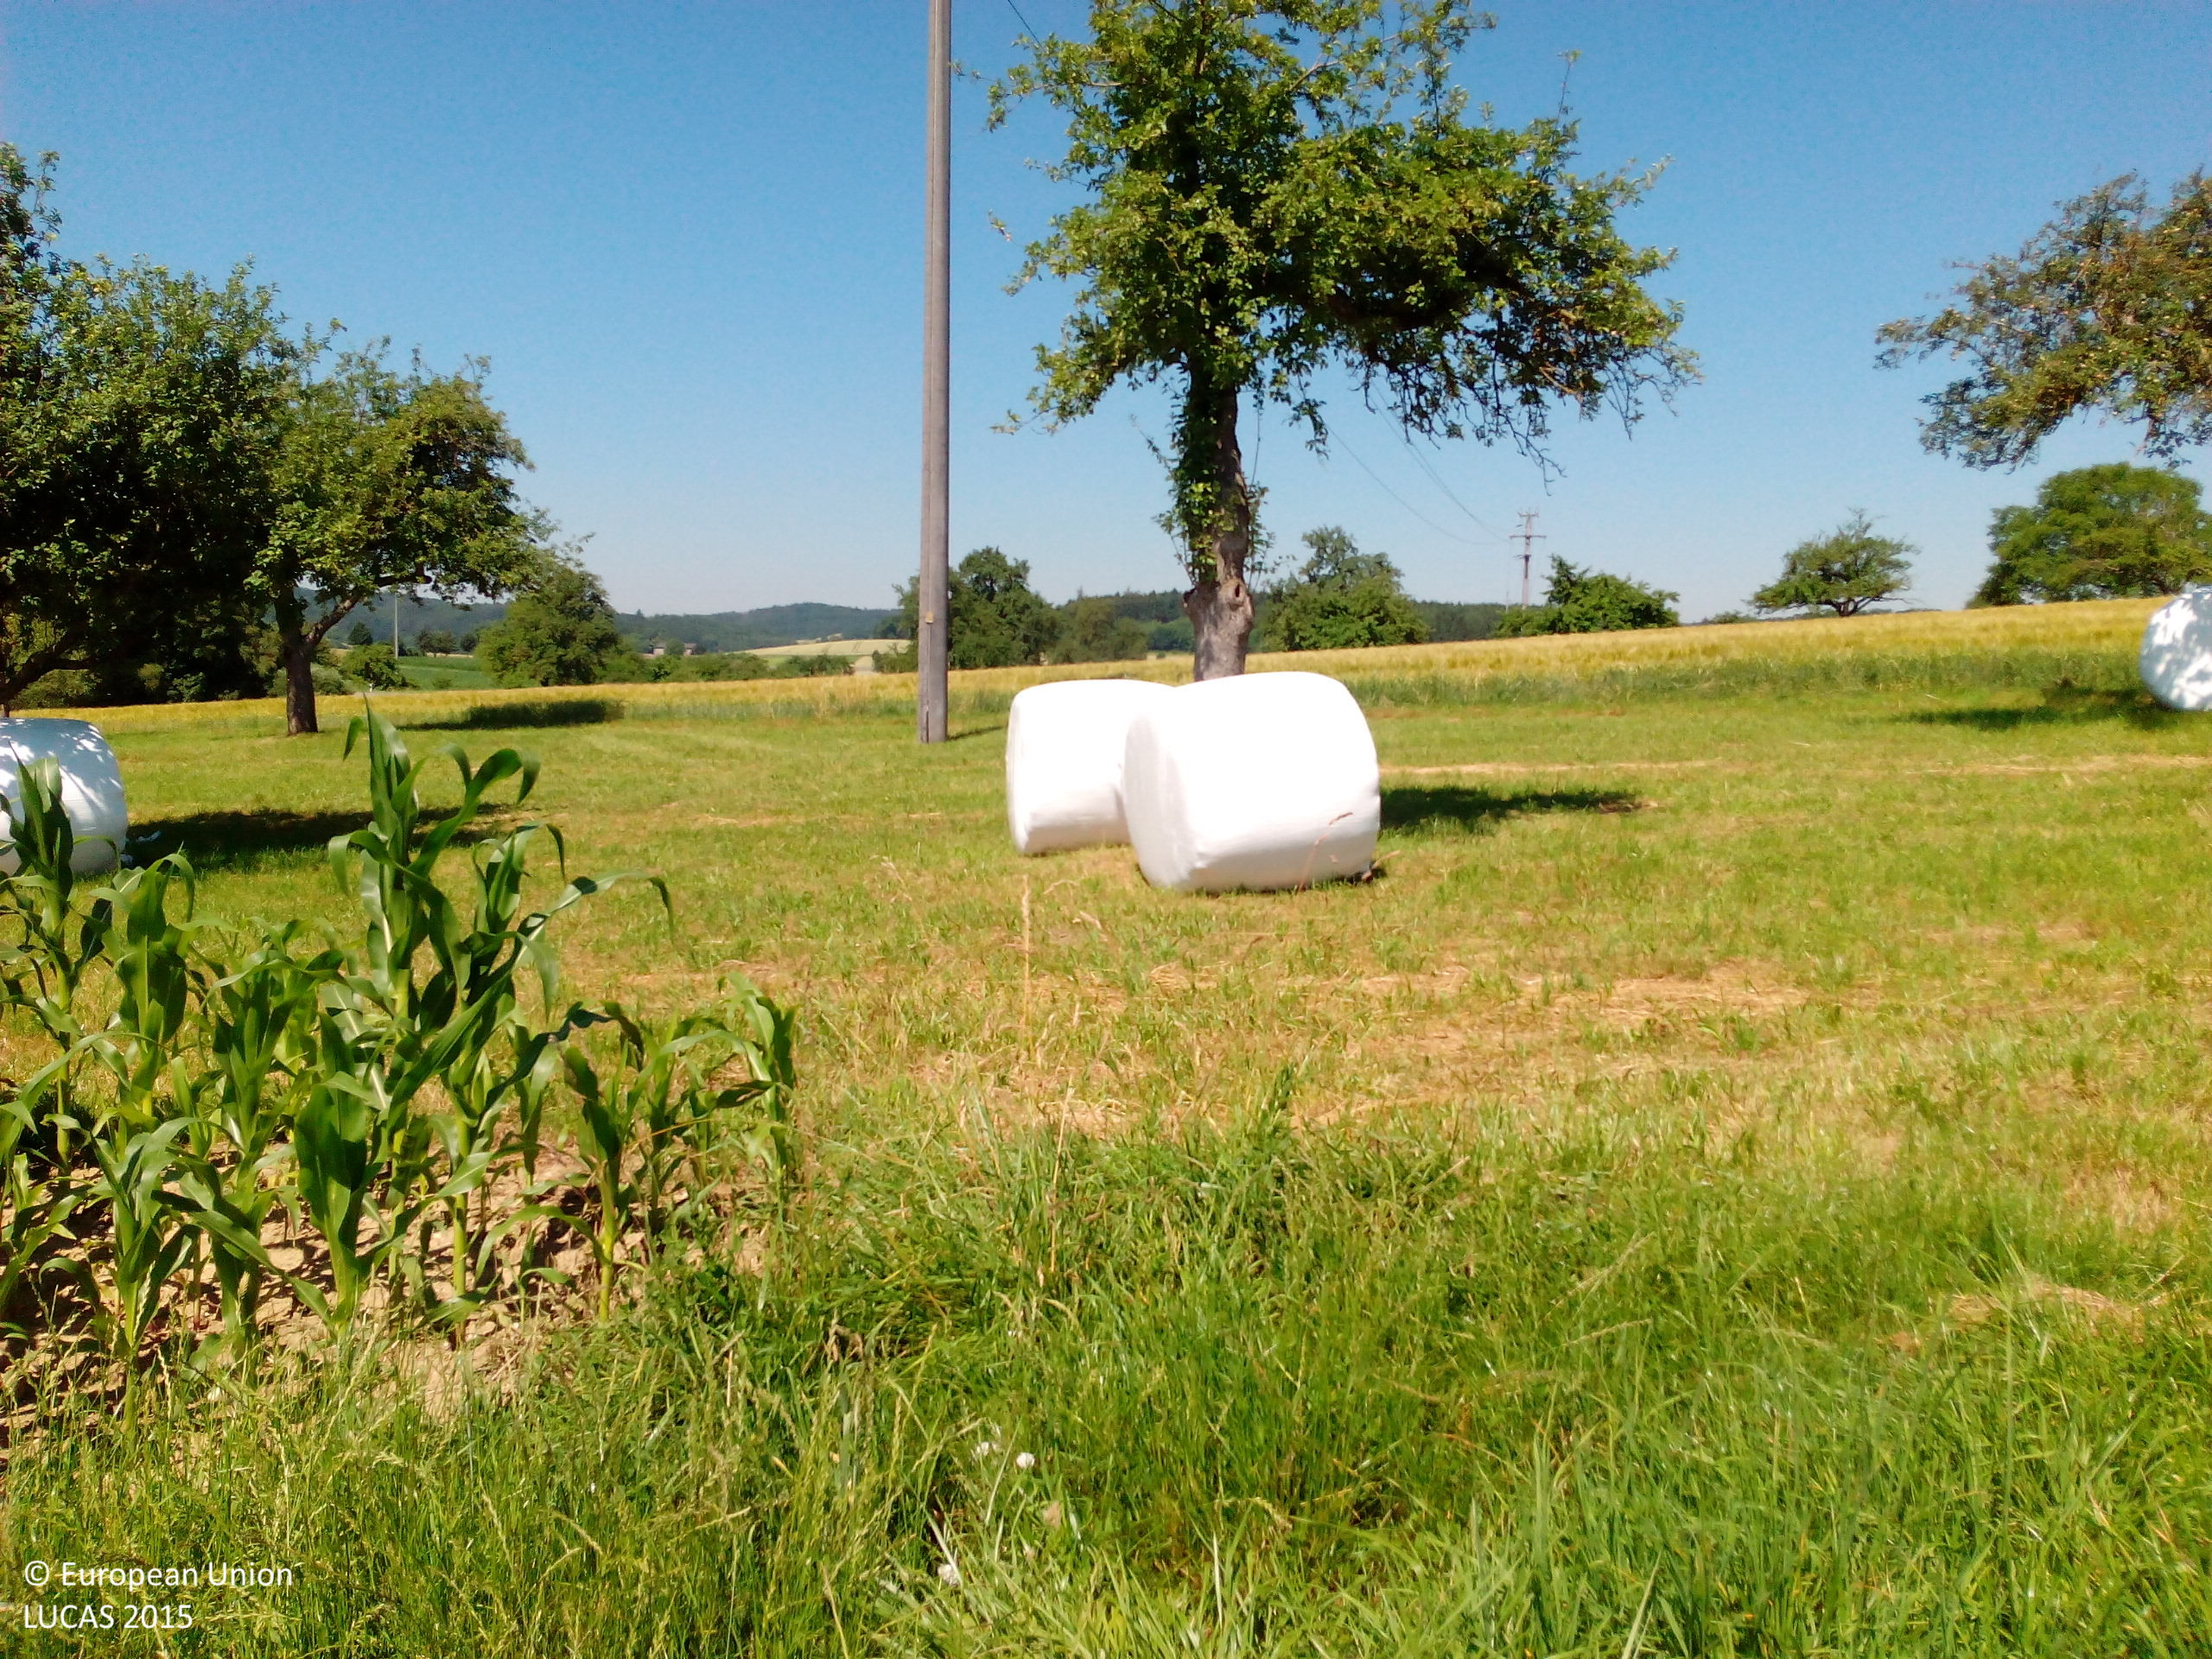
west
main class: Cropland
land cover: Maize
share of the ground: > 75 %
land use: Agriculture (excluding fallow land and kitchen gardens)
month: July
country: DE
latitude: 47.7306
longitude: 8.7609
